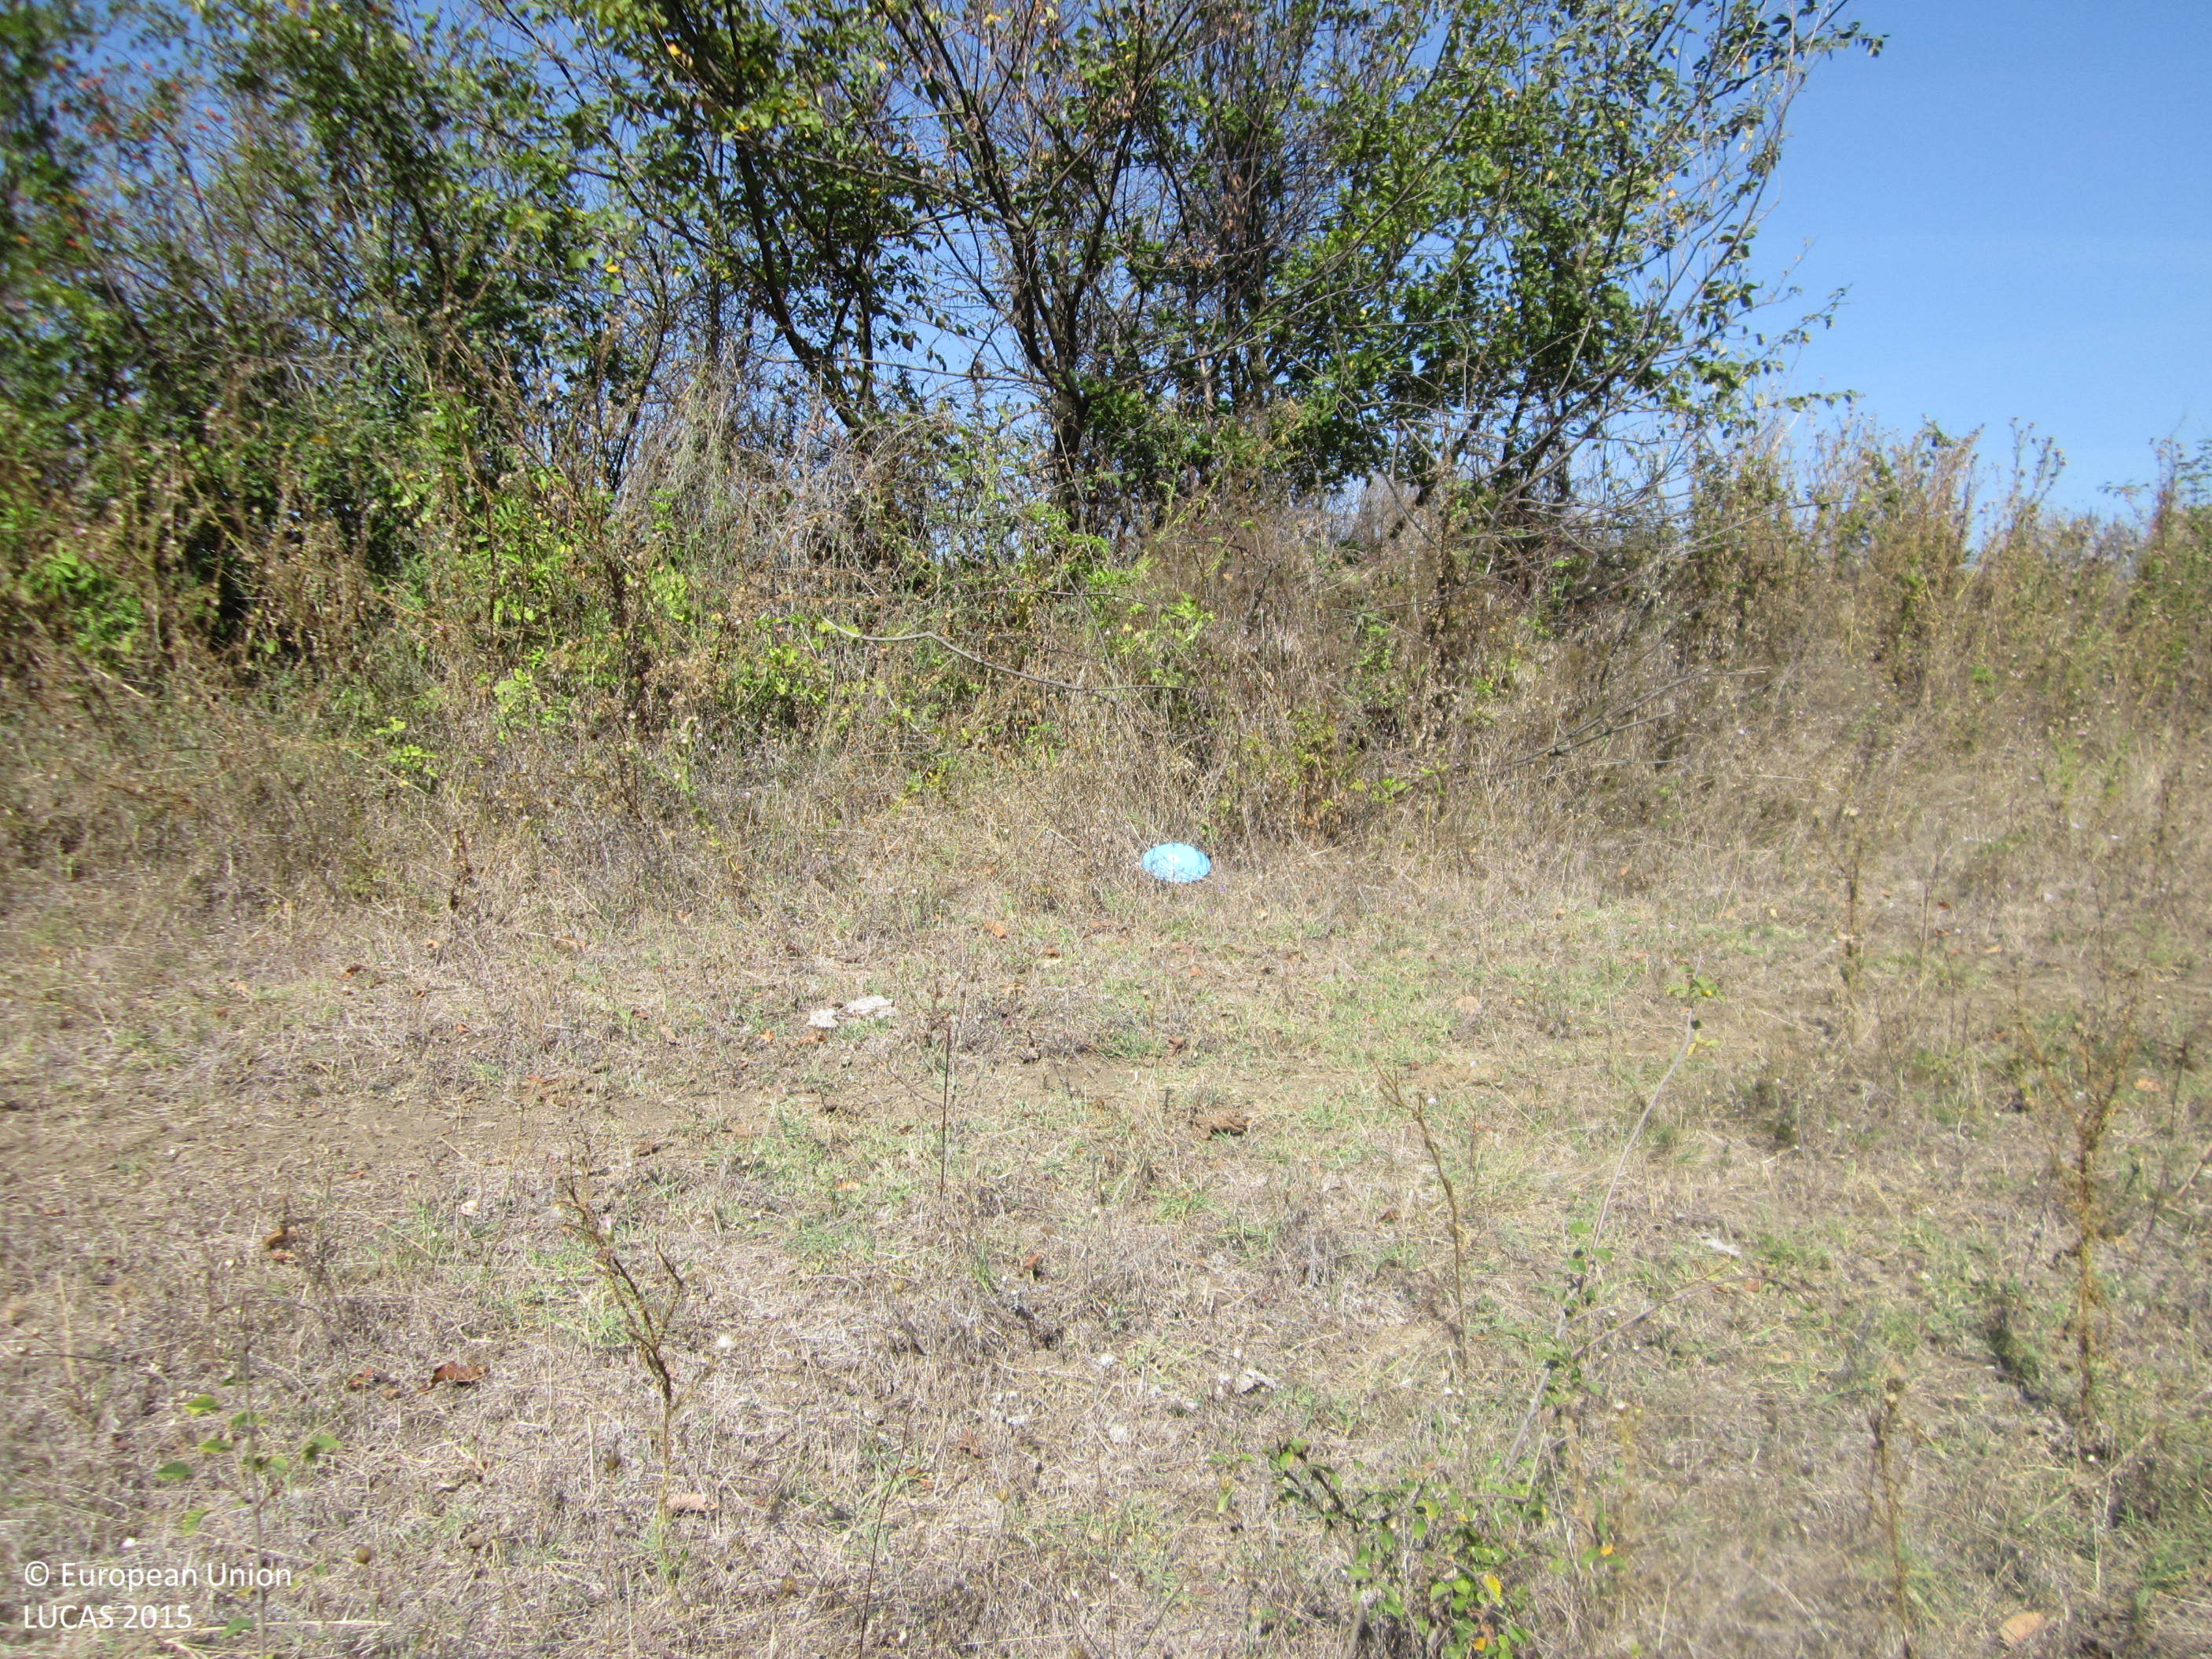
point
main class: Shrubland
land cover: Shrubland with sparse tree cover
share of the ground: 25 - 50 %
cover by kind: herbaceous plants 55 %, shrubs 40 %, broadleaved forest trees 5 %
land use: Semi-natural and natural areas not in use
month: September
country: BG
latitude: 42.7197
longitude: 27.3971
